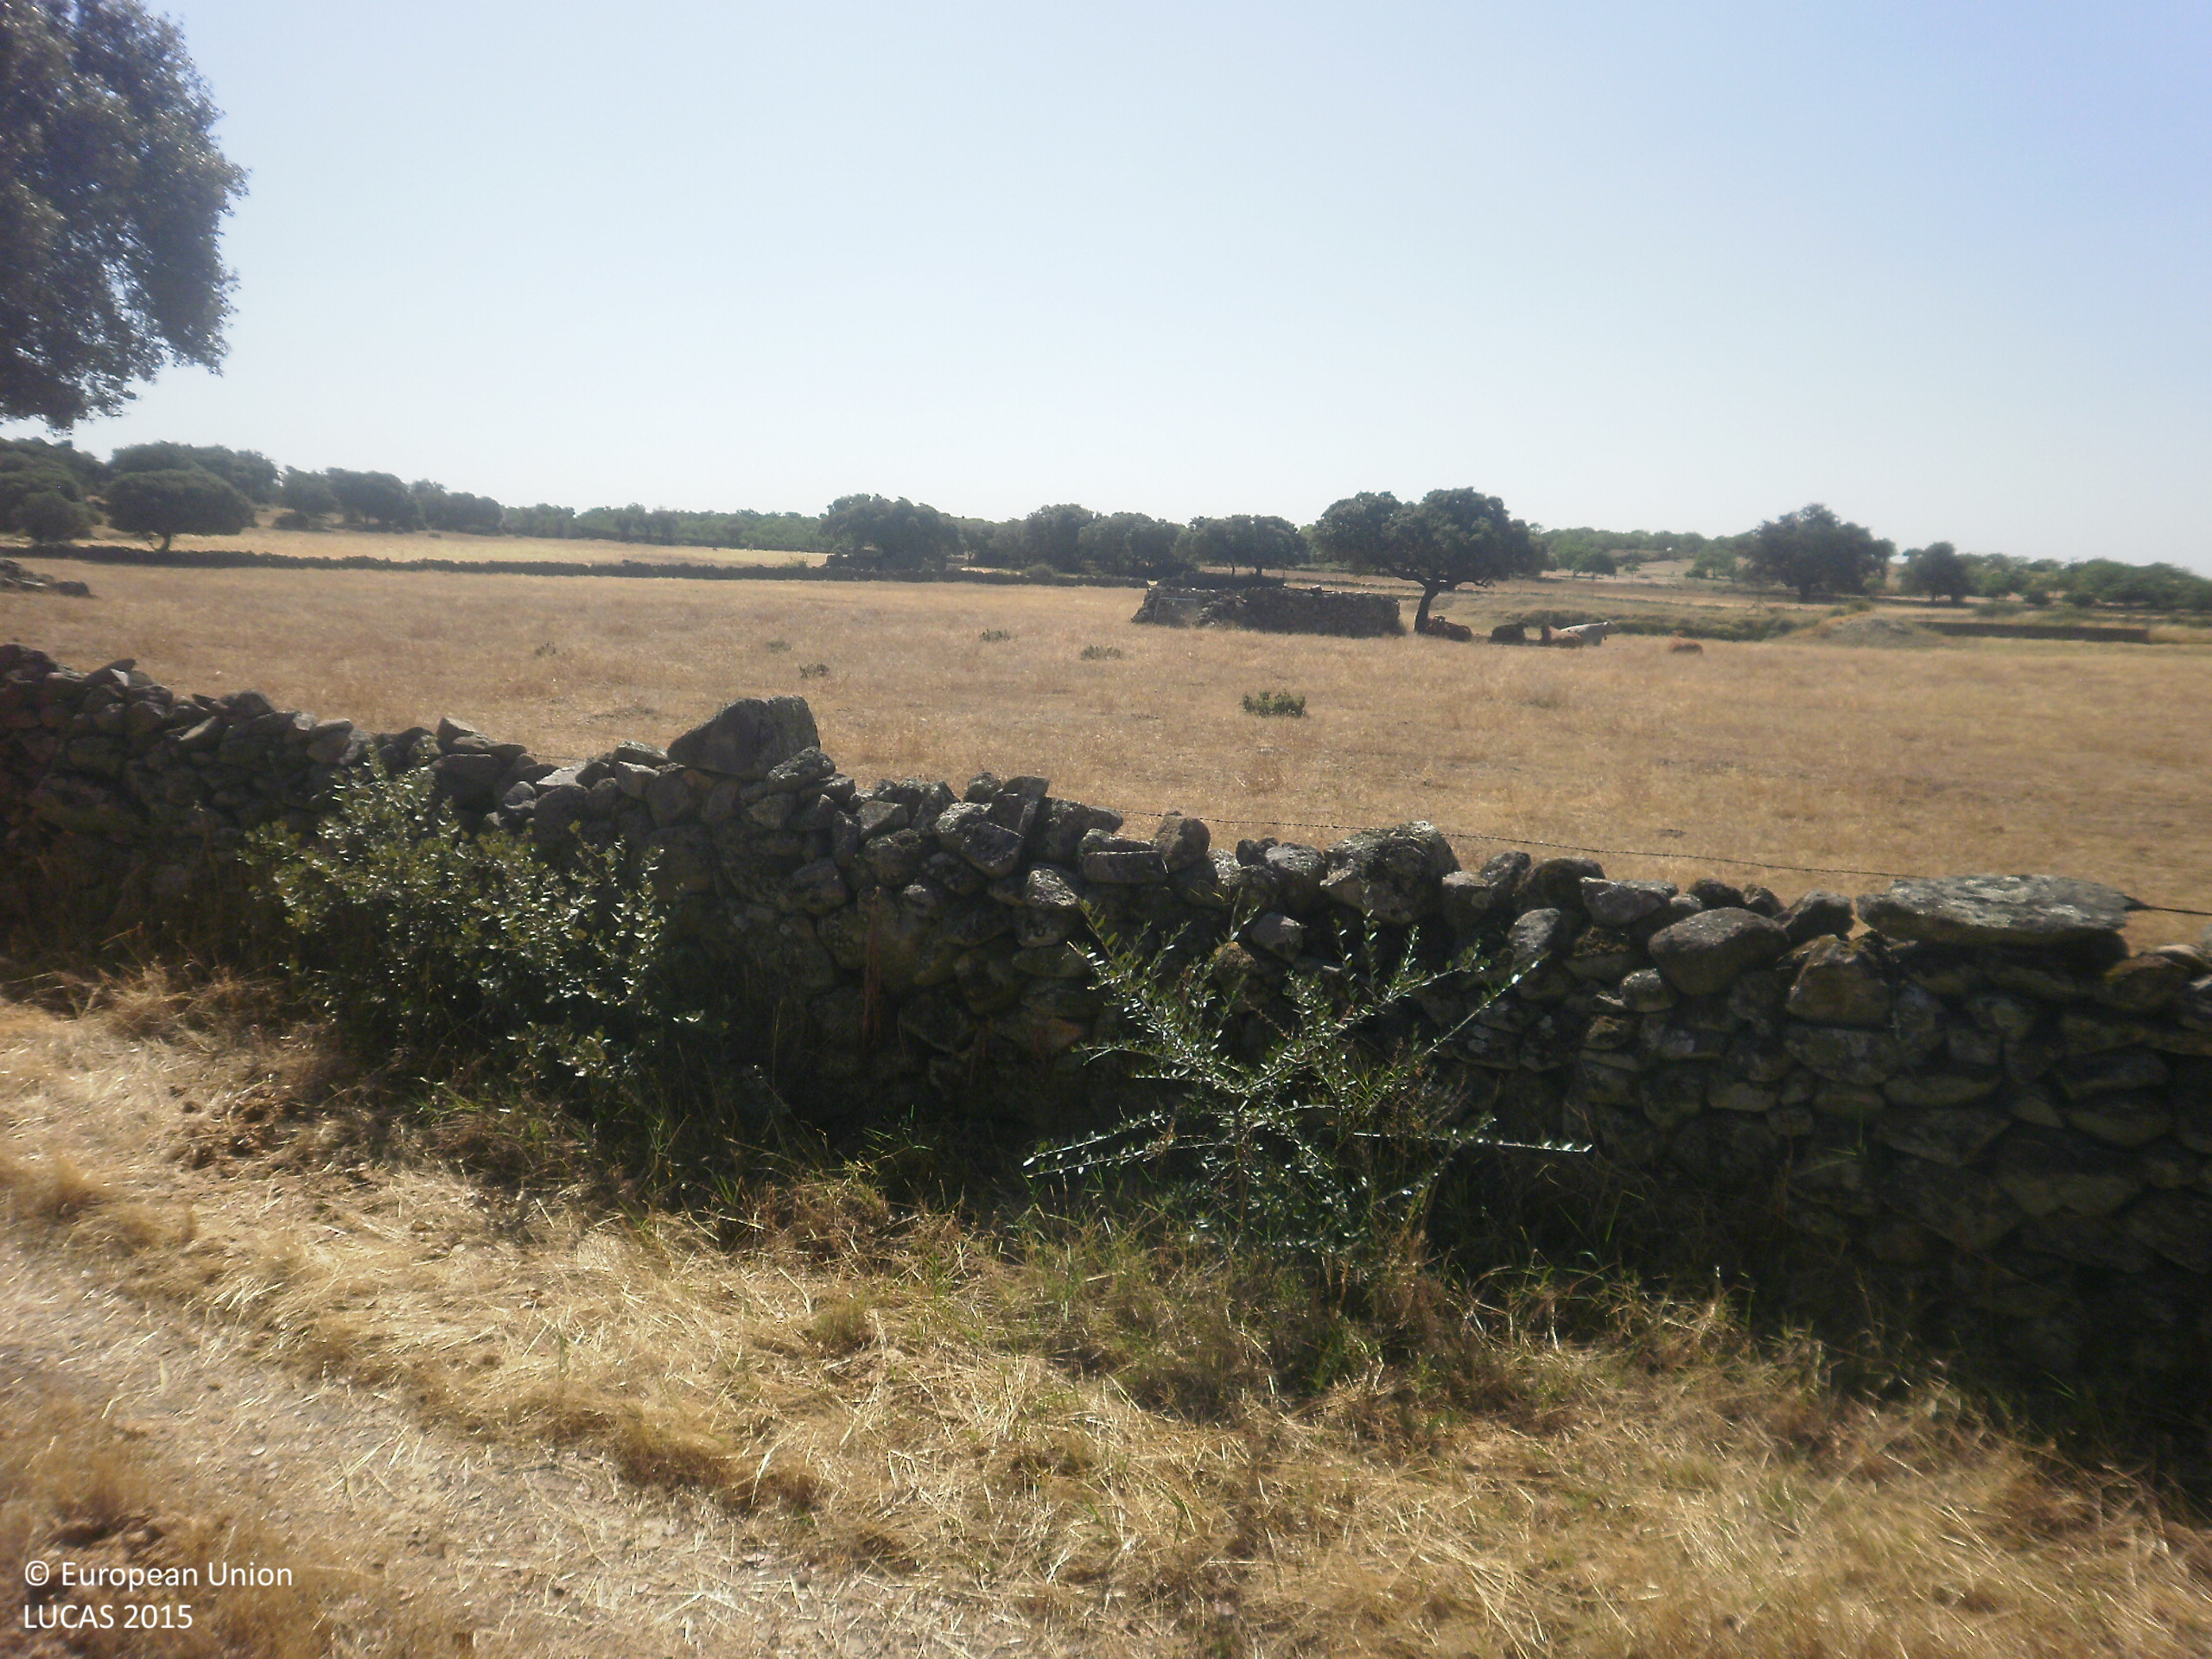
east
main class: Grassland
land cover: Grassland without tree/shrub cover
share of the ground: > 75 %
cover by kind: herbaceous plants 100 %
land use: Agriculture (excluding fallow land and kitchen gardens)
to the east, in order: Grassland without tree/shrub cover; Fences; Dry stone walls; Grass margins; Tracks; Grass margins; Dry stone walls; Grassland without tree/shrub cover; Dry stone walls; Grassland without tree/shrub cover; Broadleaved woodland
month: June
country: ES
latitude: 39.1806
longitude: -6.0196
